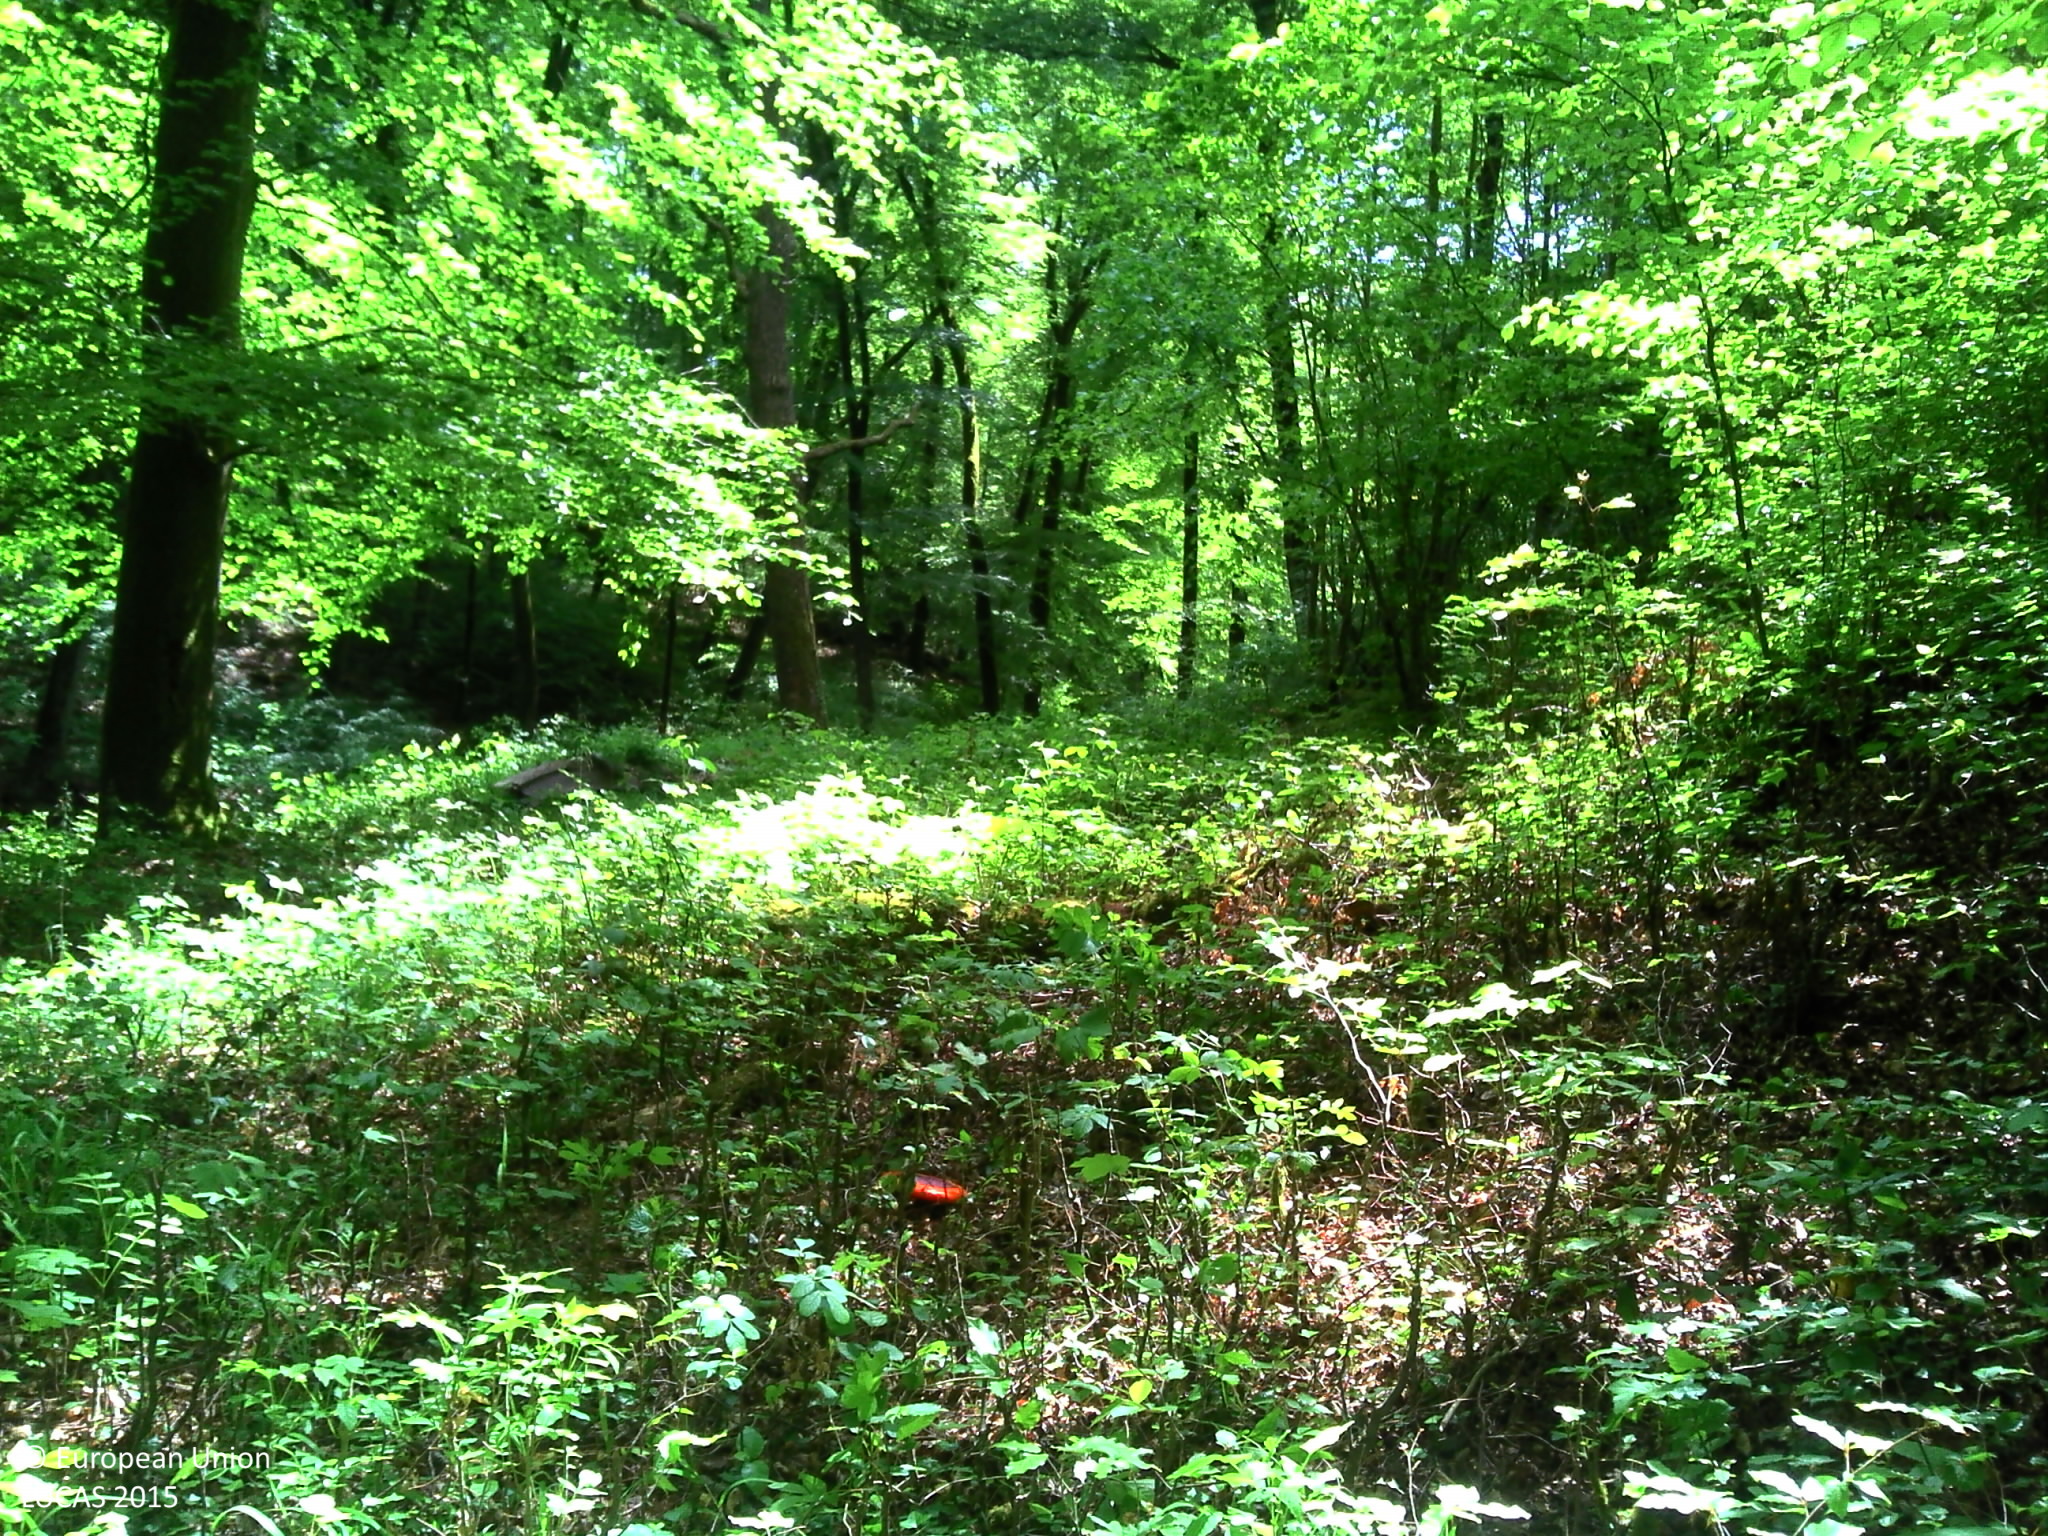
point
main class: Woodland
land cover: Broadleaved woodland
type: acidophilous oak and oak-birch forest
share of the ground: > 75 %
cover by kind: broadleaved forest trees 95 %, herbaceous plants 5 %
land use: Forestry
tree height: > 5 m
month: May
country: LU
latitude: 49.7334
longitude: 6.4618
